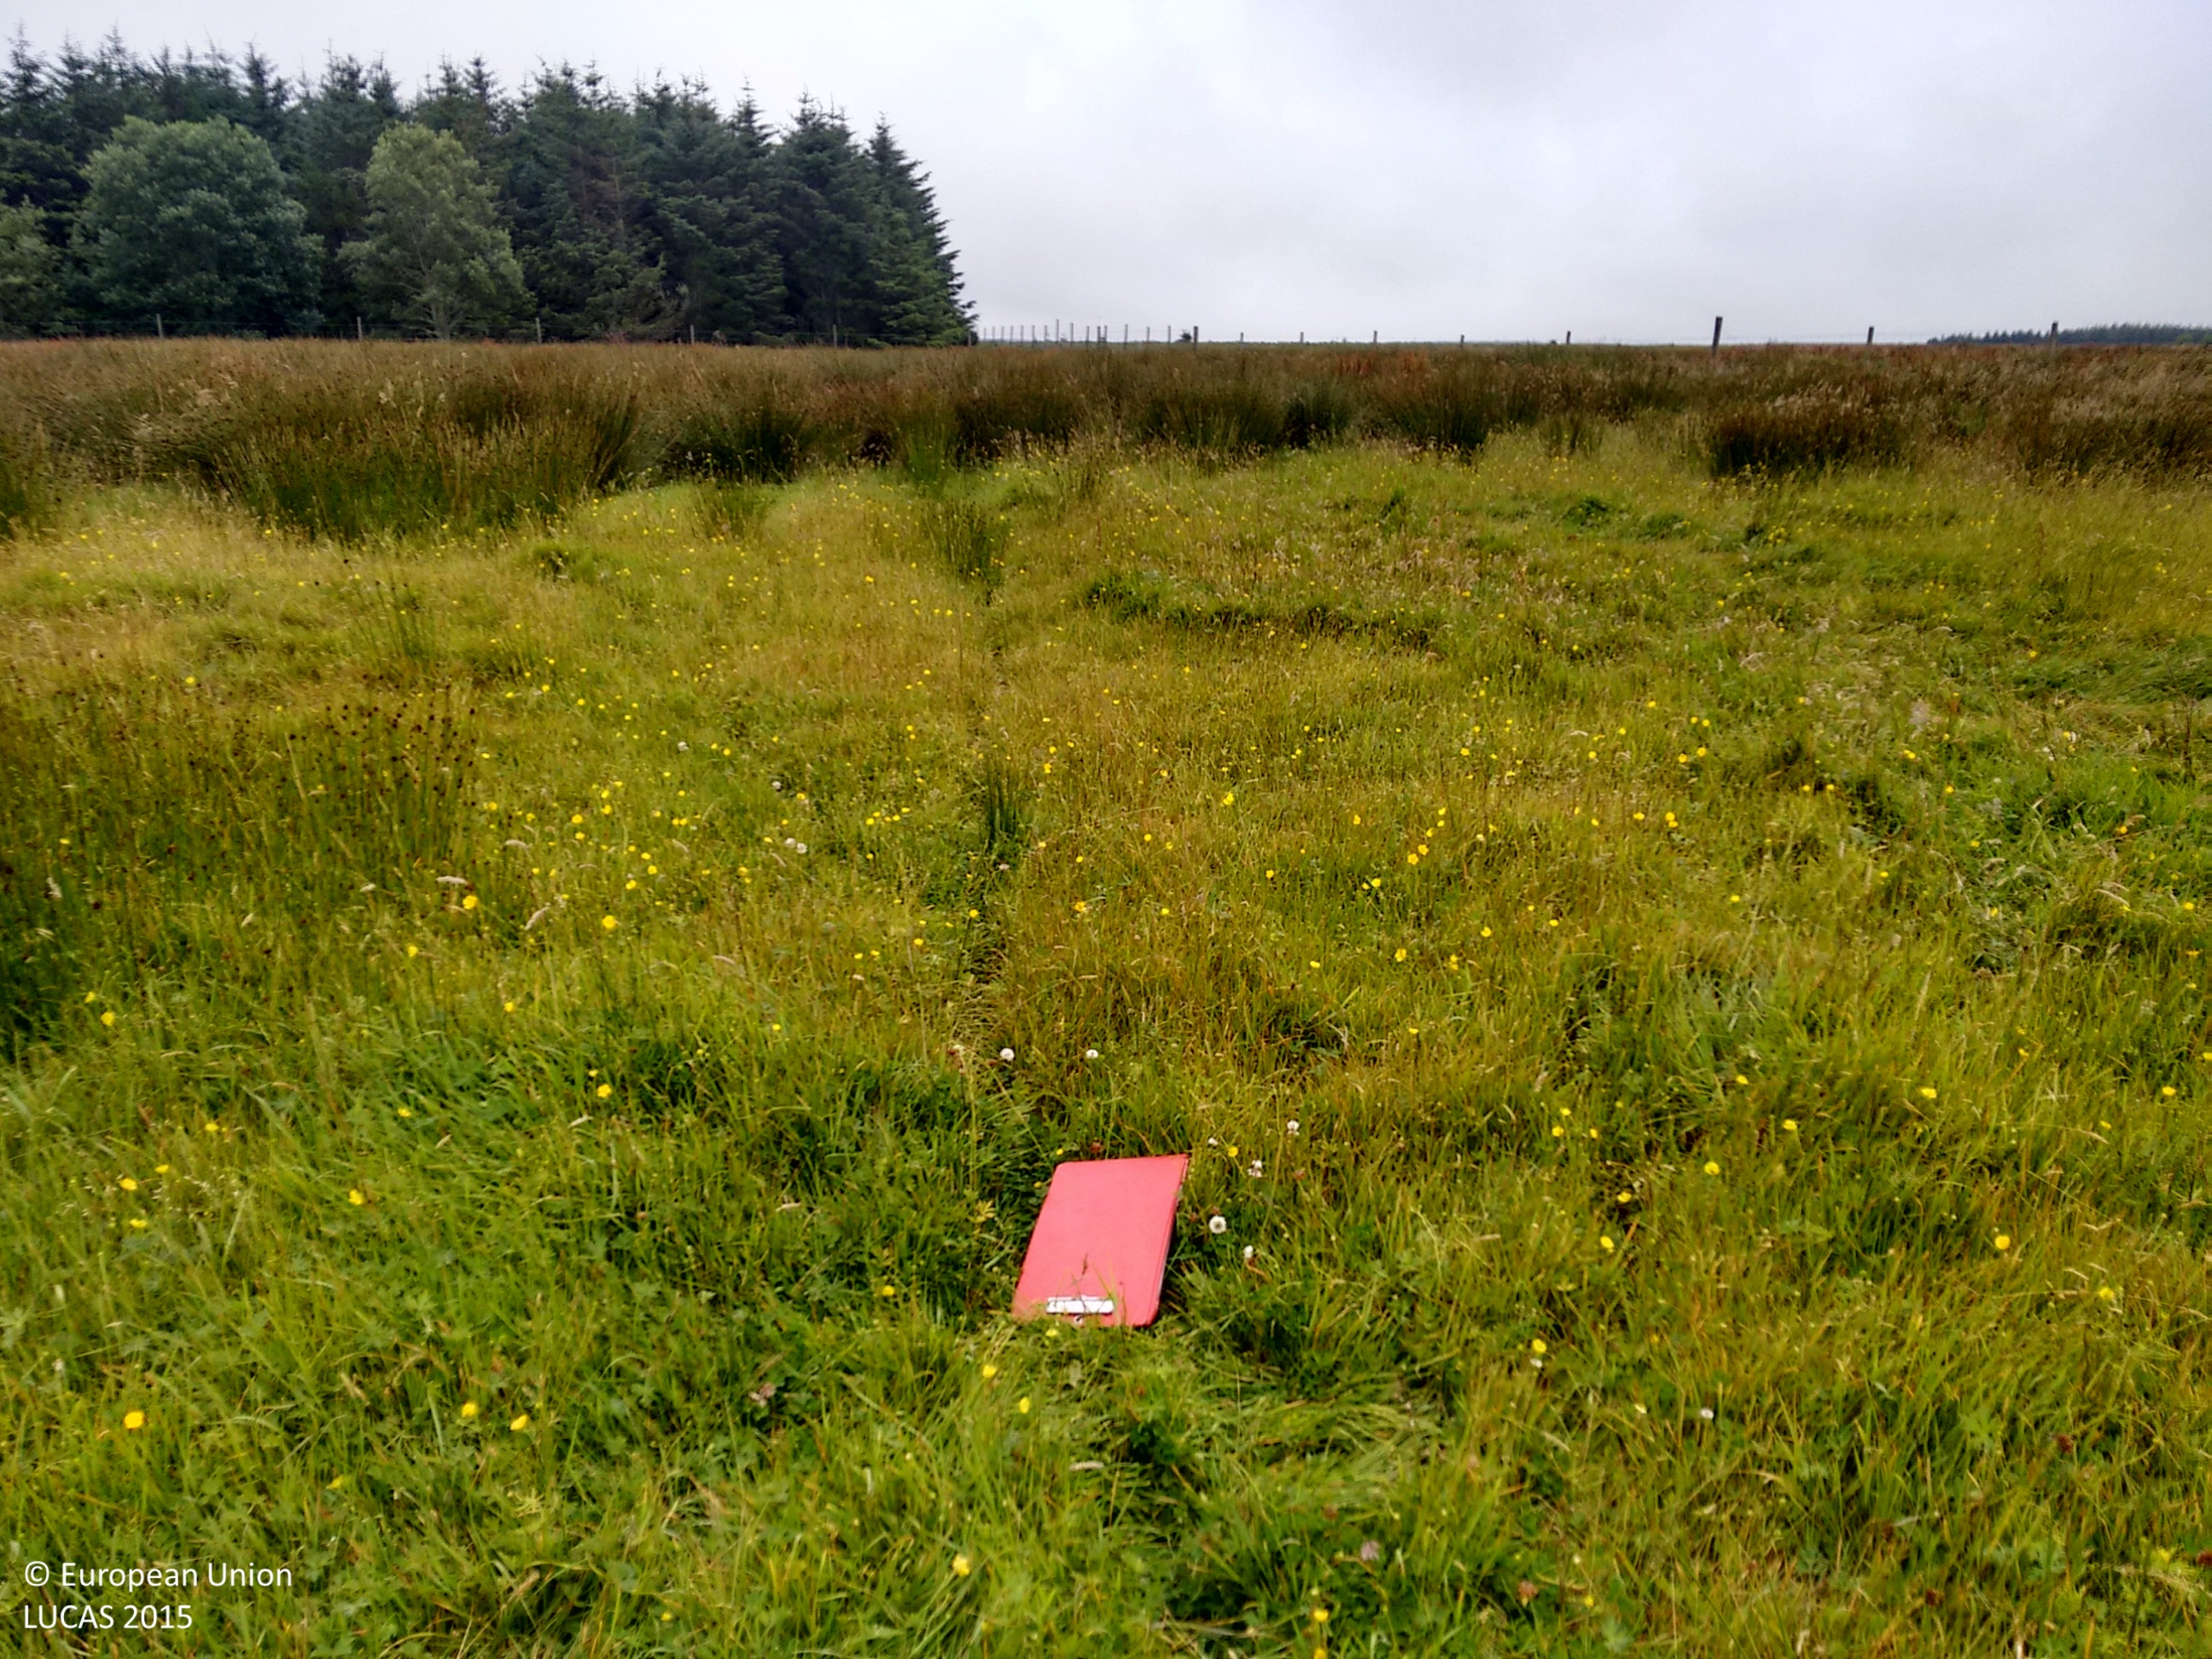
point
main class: Grassland
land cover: Grassland without tree/shrub cover
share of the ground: > 75 %
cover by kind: herbaceous plants 100 %
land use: Agriculture (excluding fallow land and kitchen gardens)
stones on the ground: < 10 %
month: August
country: GB
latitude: 58.4306
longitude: -3.1249
